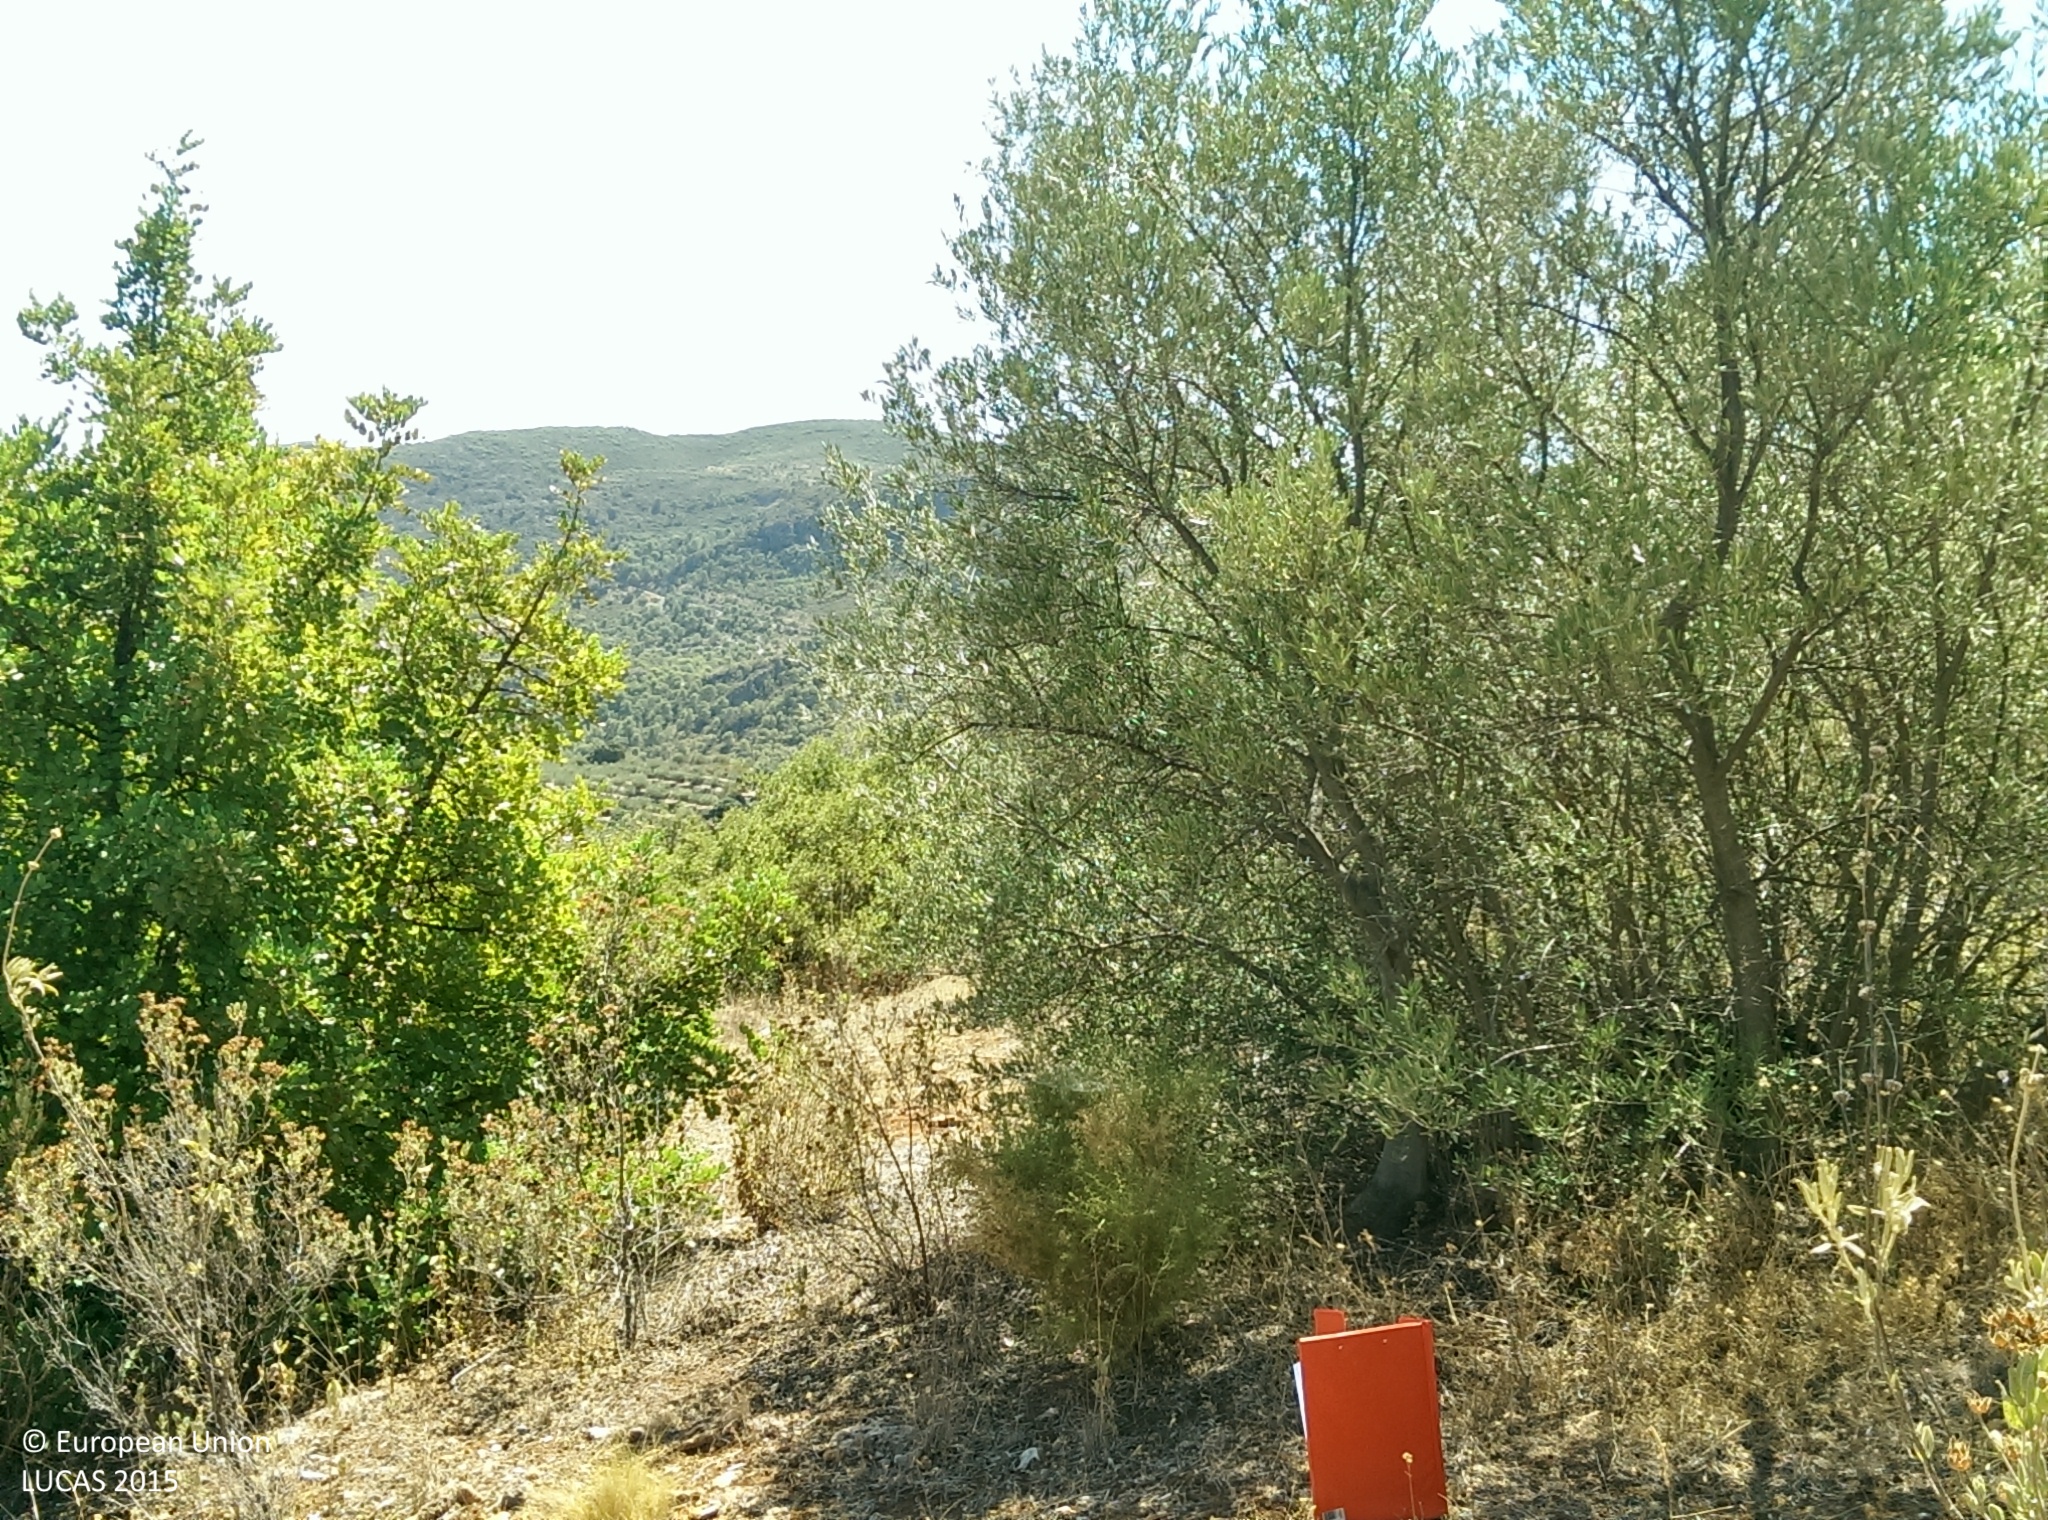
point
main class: Cropland
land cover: Olive groves
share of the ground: 25 - 50 %
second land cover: Spontaneously vegetated surfaces
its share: 10 - 25 %
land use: Abandoned areas
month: August
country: ES
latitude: 36.8525
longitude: -3.6333
